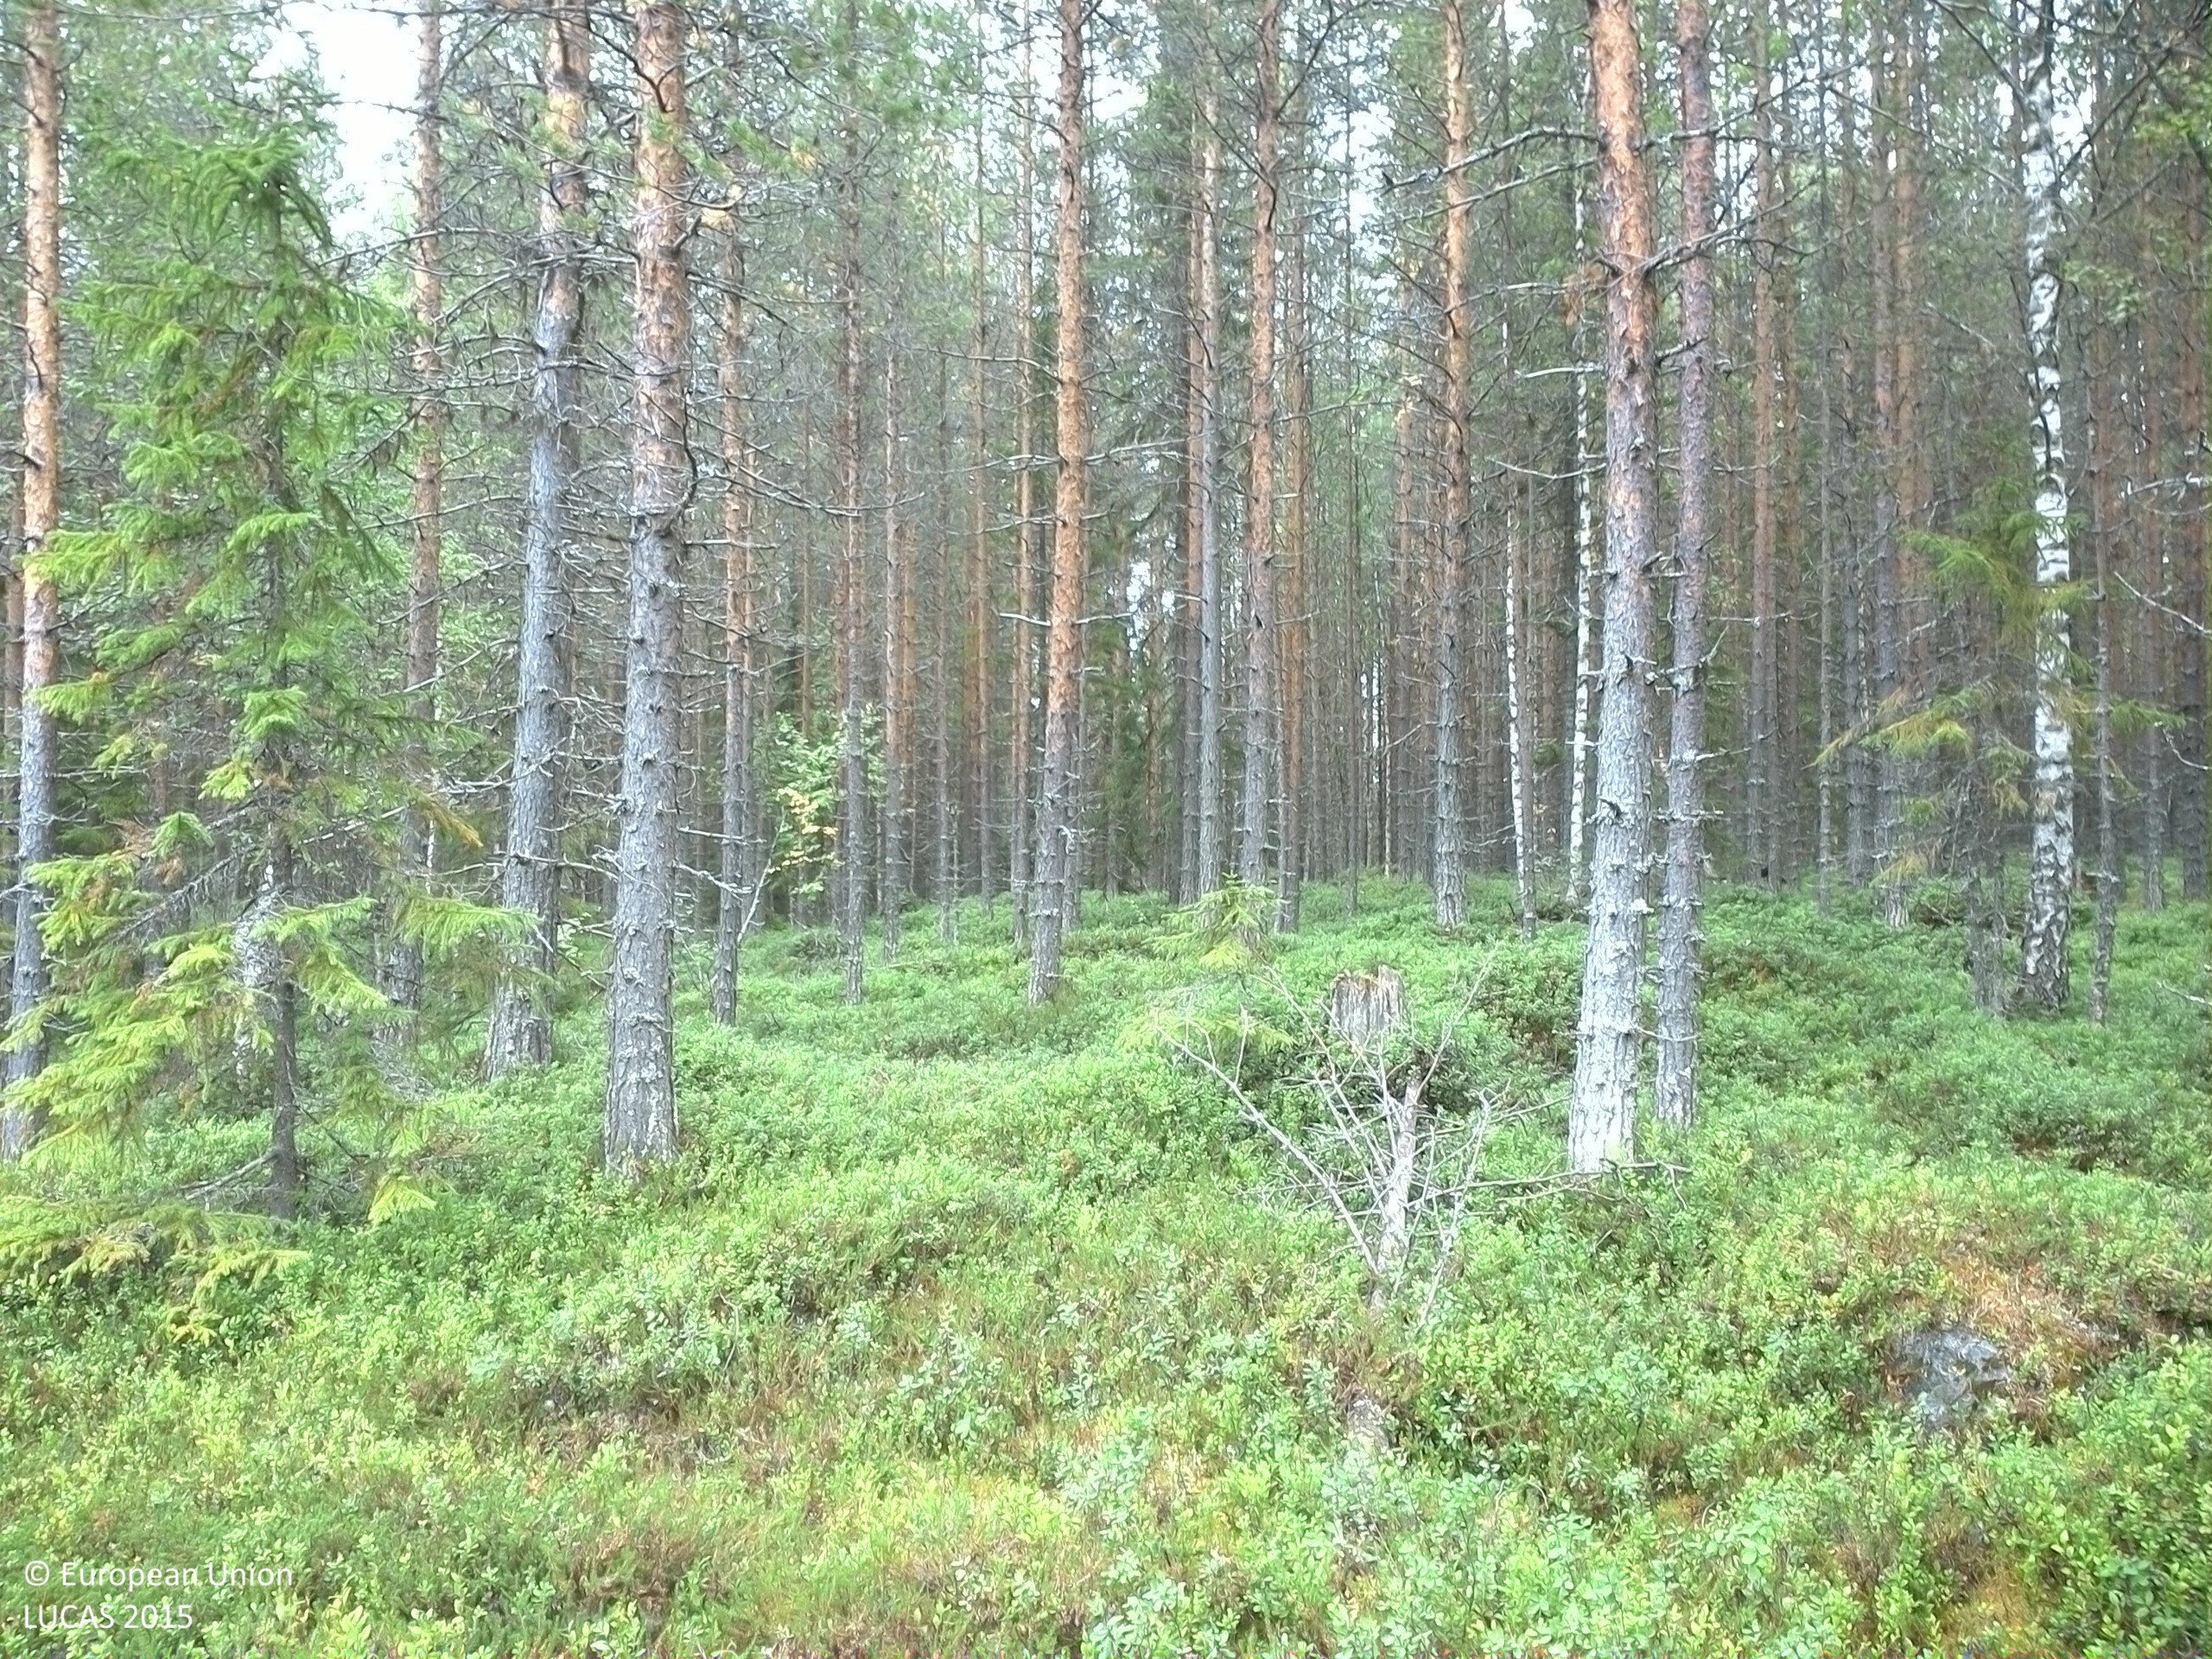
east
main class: Woodland
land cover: Pine dominated coniferous woodland
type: boreal forest
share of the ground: > 75 %
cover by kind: coniferous forest trees 70 %, shrubs 15 %, lichens and mosses 15 %
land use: Forestry
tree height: > 5 m
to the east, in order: Pine dominated coniferous woodland; Other mixed woodland; Broadleaved woodland; Pine dominated mixed woodland
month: August
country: SE
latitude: 63.9580
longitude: 17.2999
